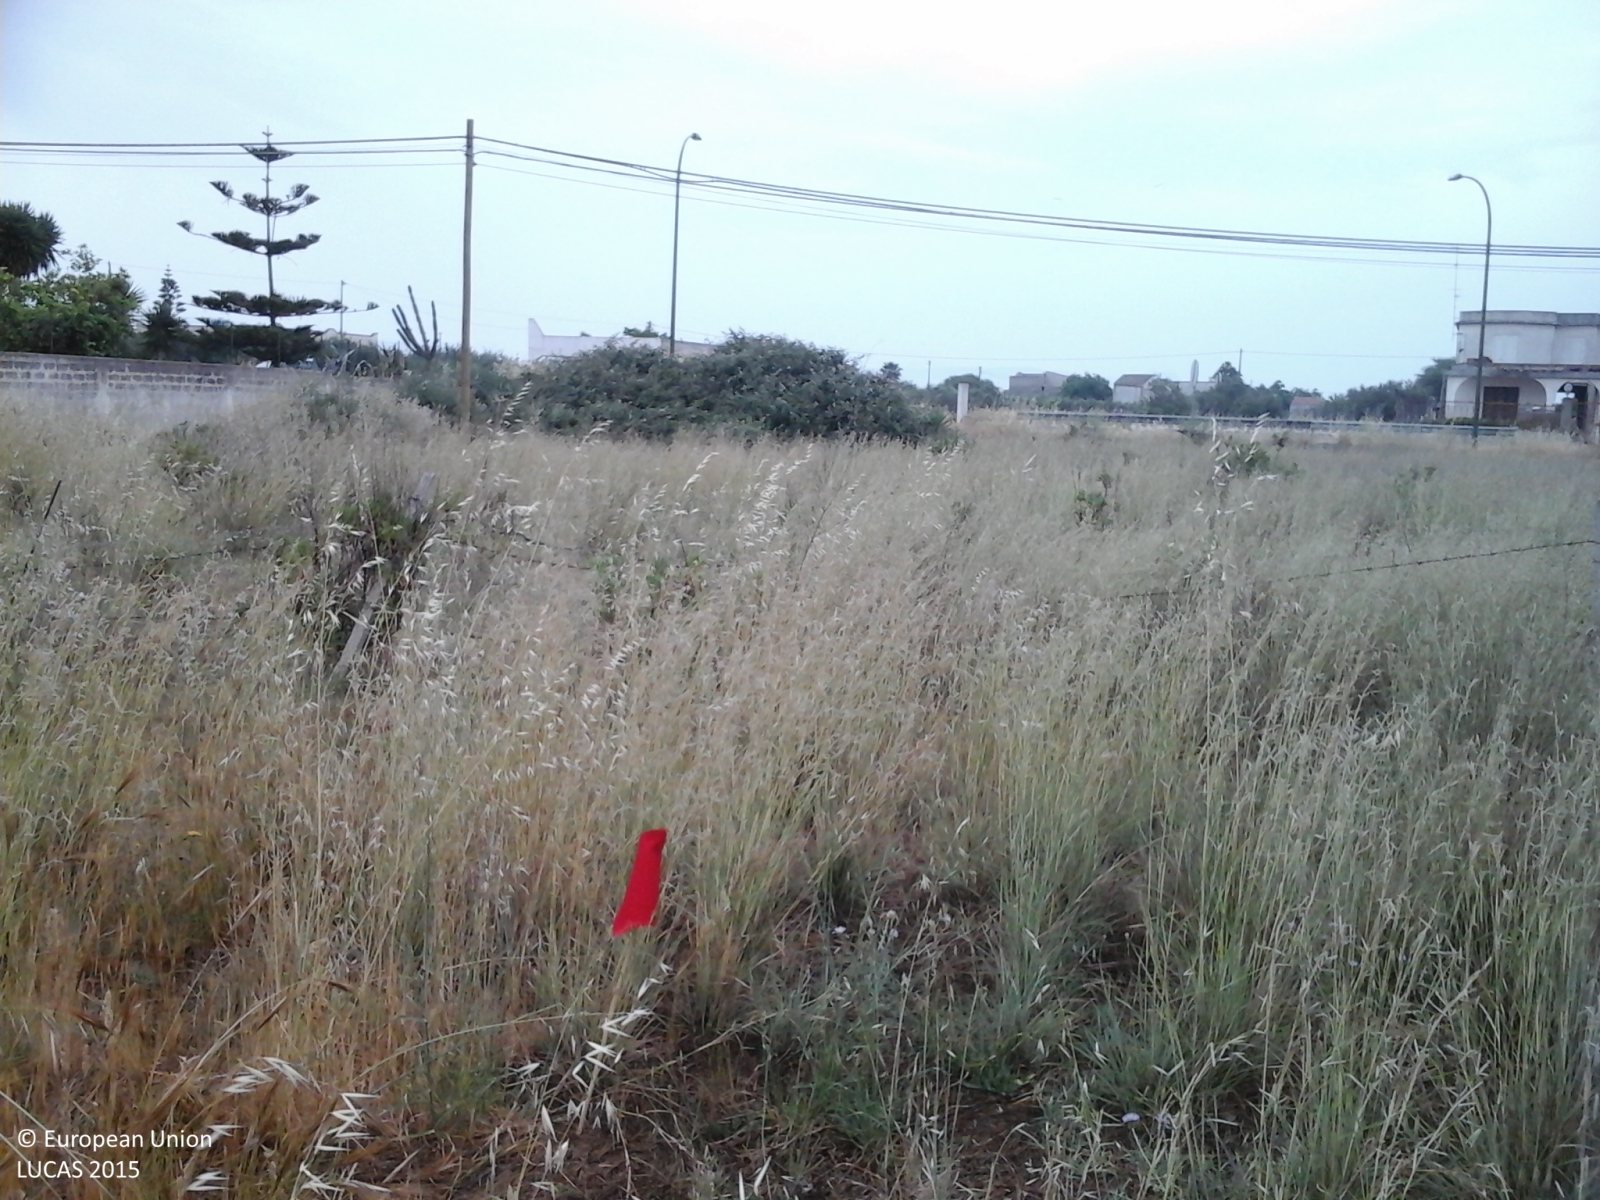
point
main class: Grassland
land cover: Spontaneously vegetated surfaces
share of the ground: > 75 %
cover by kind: herbaceous plants 95 %, shrubs 5 %
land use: Fallow land
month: May
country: IT
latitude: 37.6142
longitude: 12.8445
